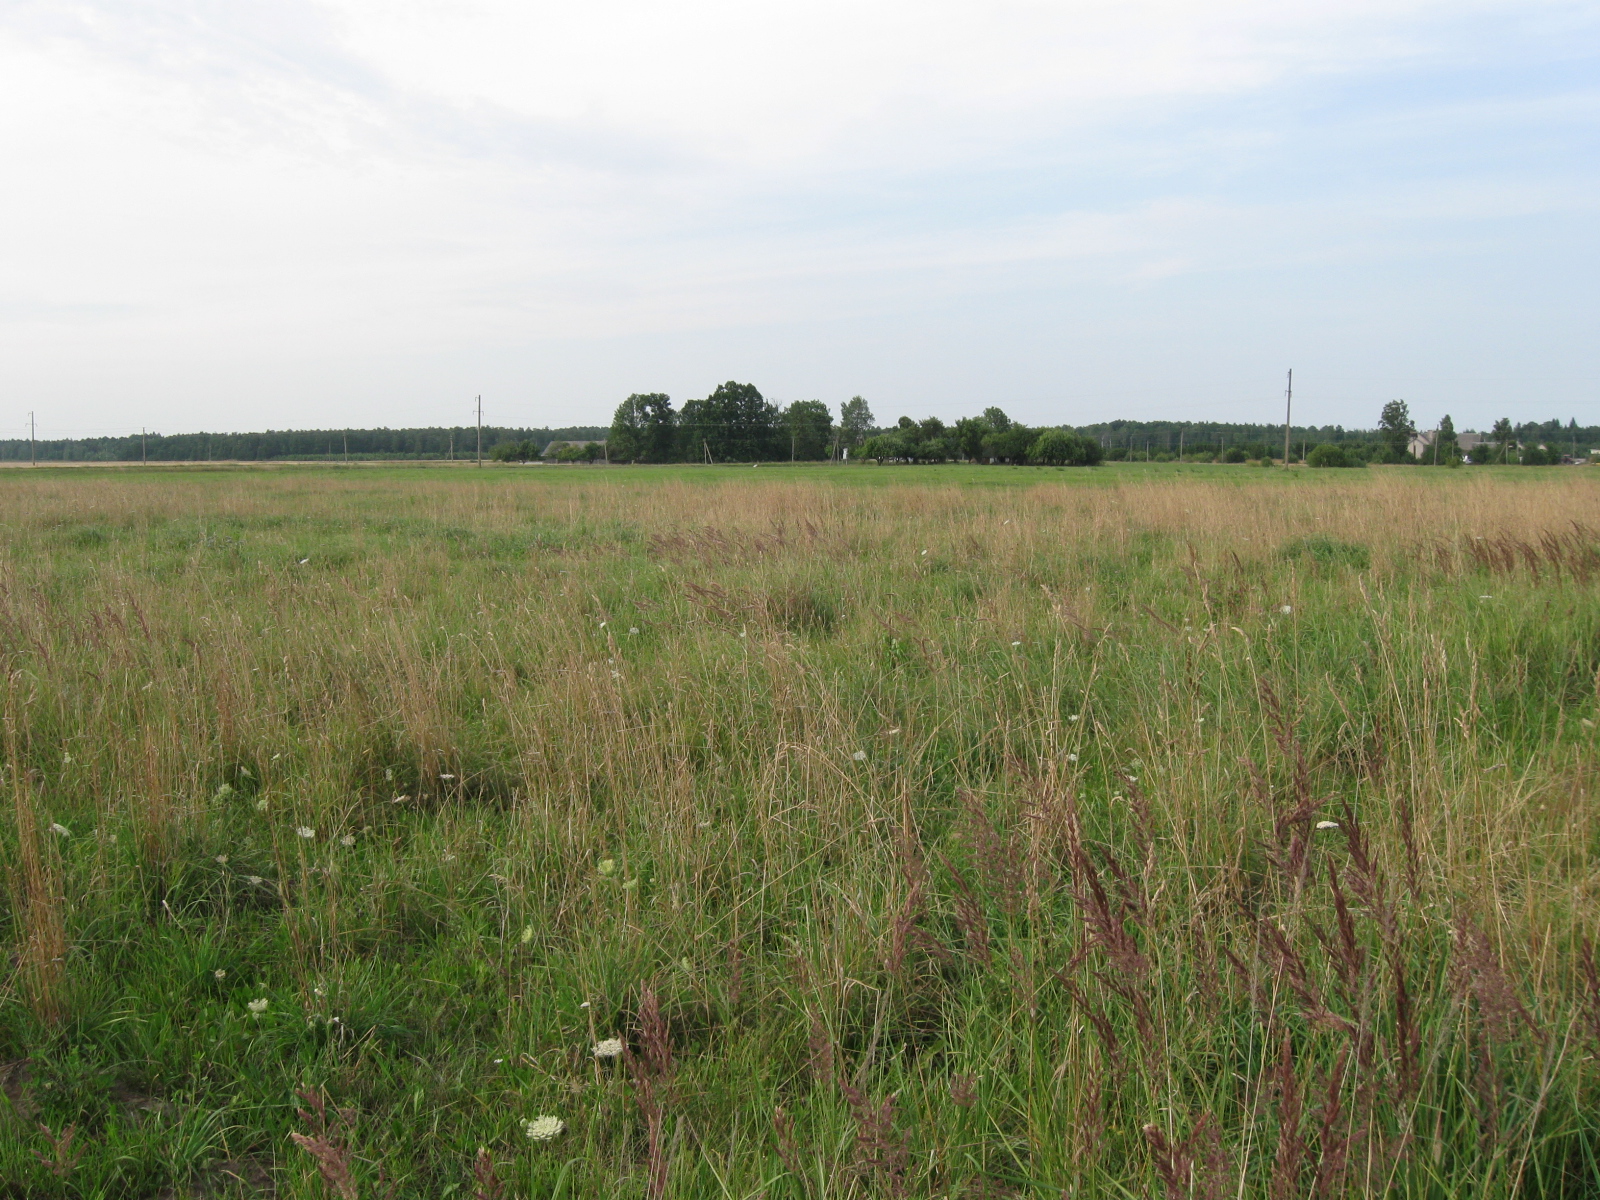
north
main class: Grassland
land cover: Grassland with sparse tree/shrub cover
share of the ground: > 75 %
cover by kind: herbaceous plants 90 %, broadleaved forest trees 5 %, shrubs 5 %
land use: Agriculture (excluding fallow land and kitchen gardens)
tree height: < 5 m
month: July
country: LT
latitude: 54.6864
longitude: 23.8160
